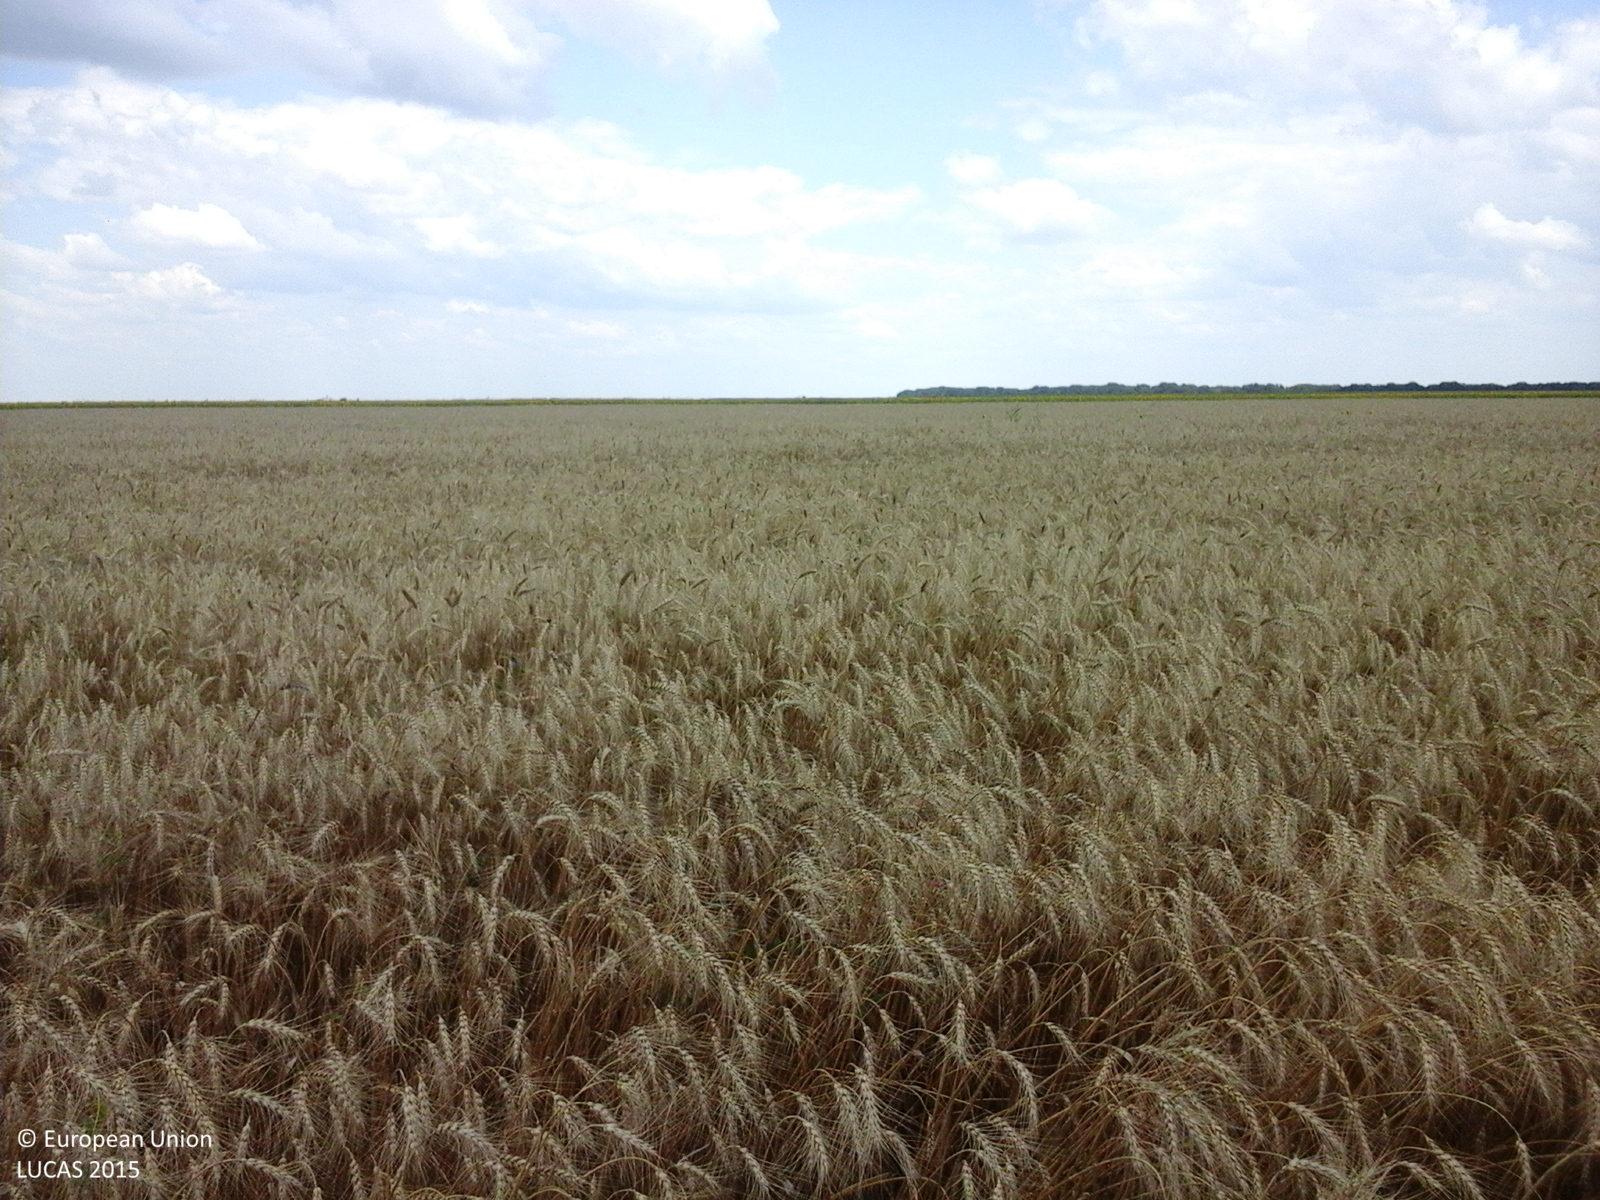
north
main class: Cropland
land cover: Common wheat
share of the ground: > 75 %
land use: Agriculture (excluding fallow land and kitchen gardens)
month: July
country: RO
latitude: 44.0072
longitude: 24.7259
